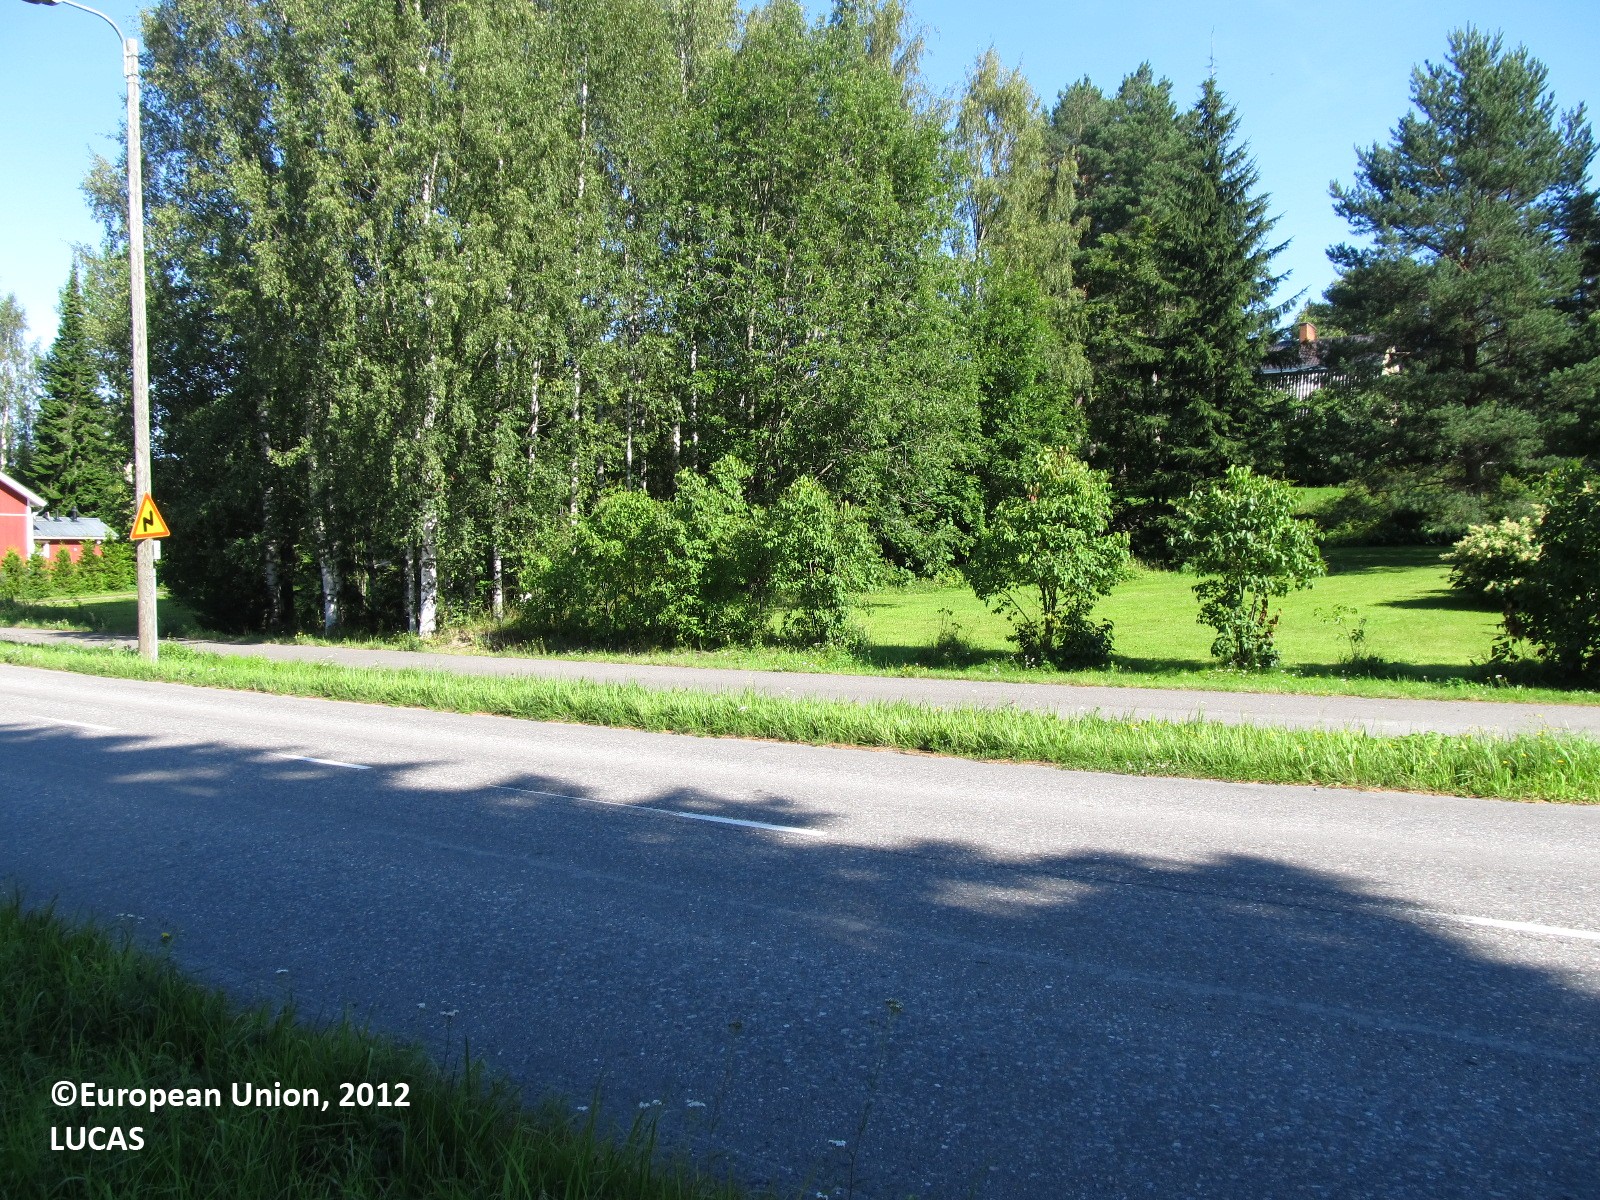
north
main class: Grassland
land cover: Spontaneously vegetated surfaces
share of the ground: > 75 %
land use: Road transport
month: August
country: FI
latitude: 62.3485
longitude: 27.8534
